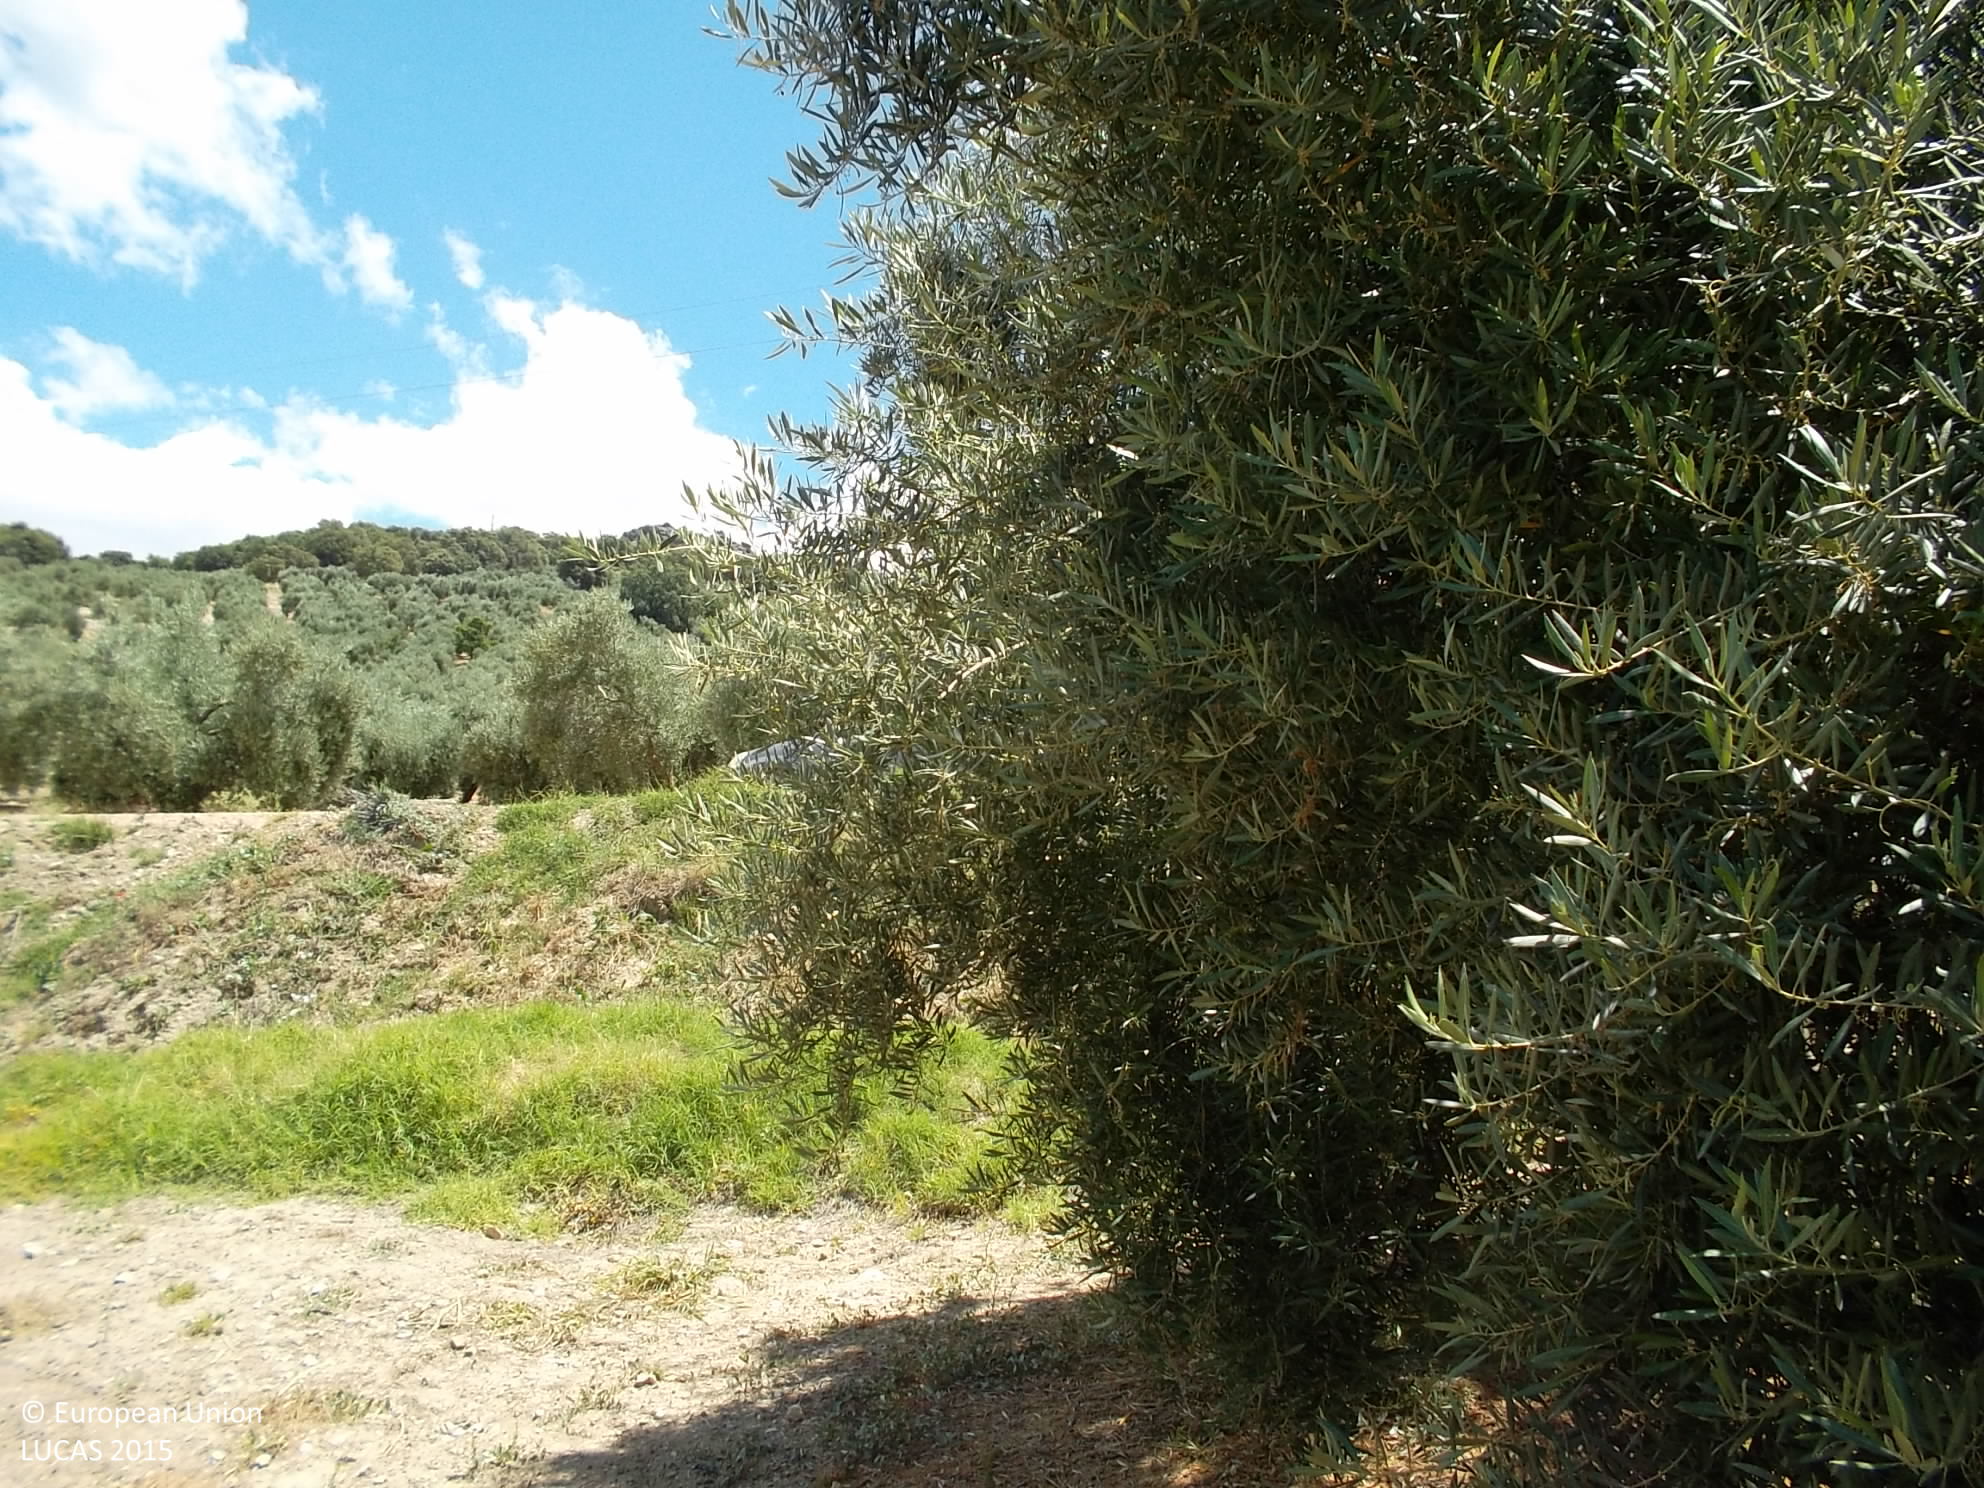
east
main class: Cropland
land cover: Olive groves
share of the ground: 25 - 50 %
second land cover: Other bare soil
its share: > 75 %
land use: Agriculture (excluding fallow land and kitchen gardens)
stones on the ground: < 10 %
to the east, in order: Olive groves; Other bare soil; Grass margins; Tracks; Olive groves; Electric lines; Olive groves
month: June
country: ES
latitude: 37.9570
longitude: -2.9587
